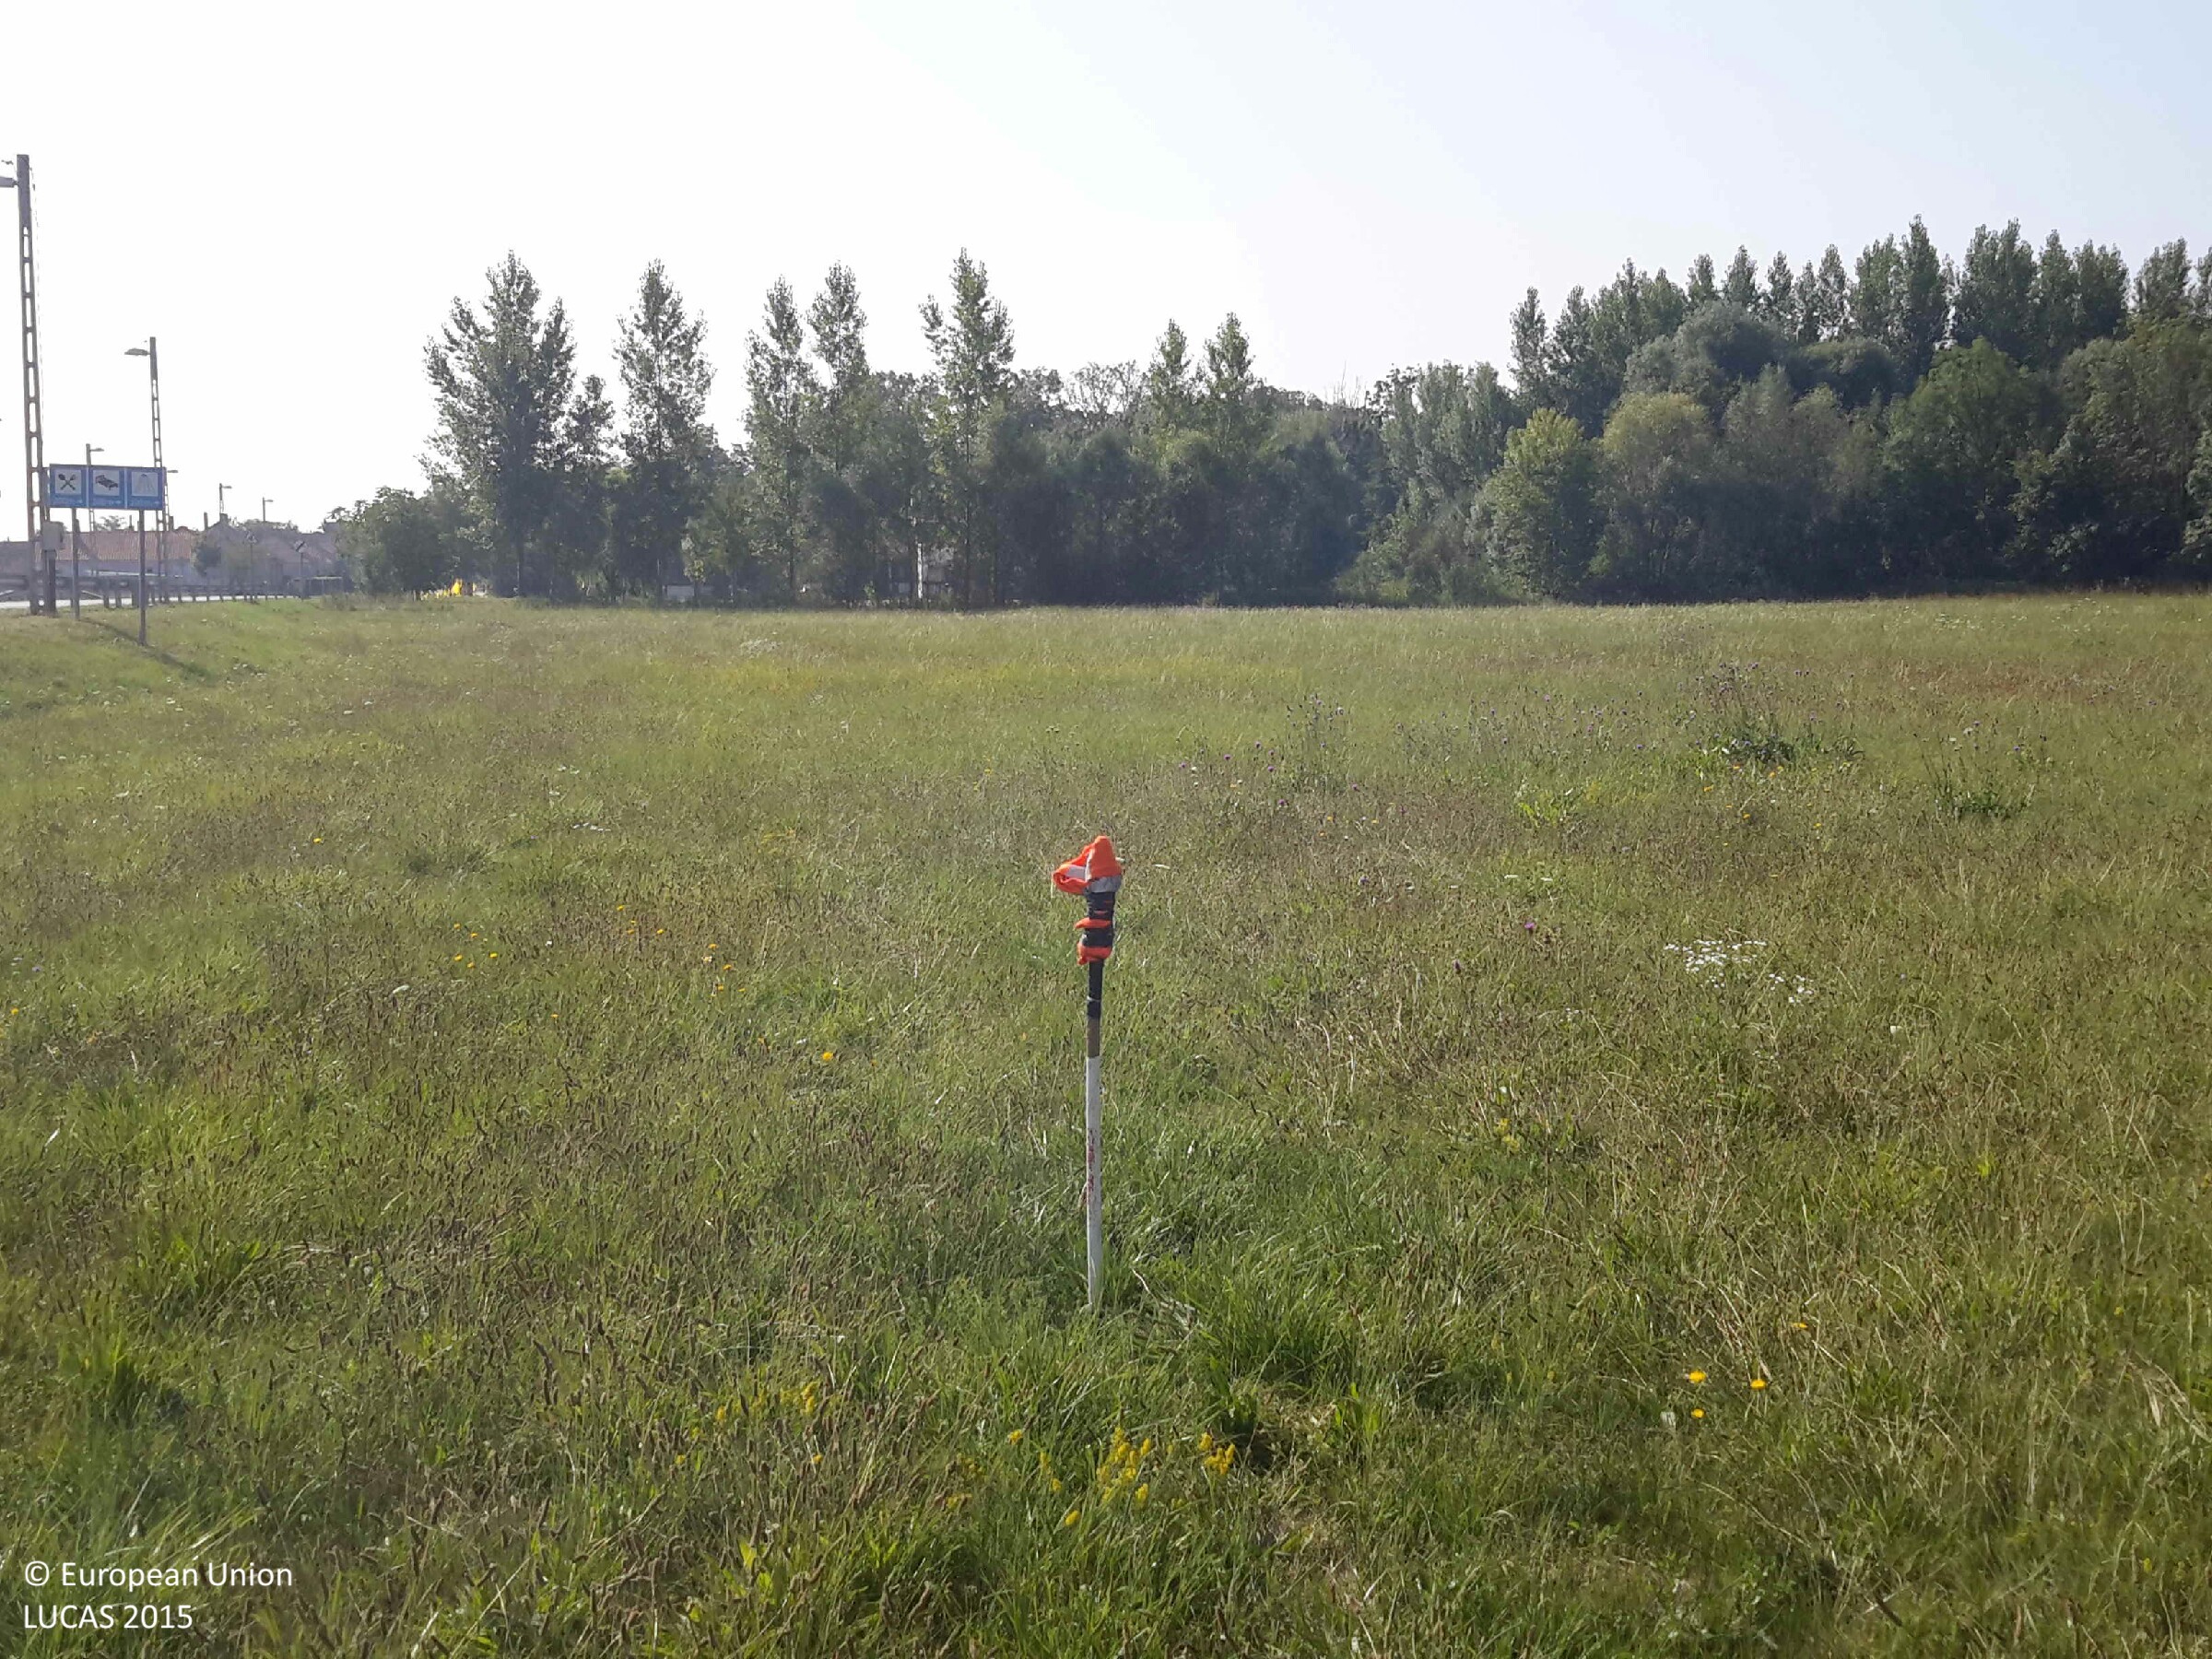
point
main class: Grassland
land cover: Grassland without tree/shrub cover
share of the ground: > 75 %
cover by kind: herbaceous plants 100 %
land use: Agriculture (excluding fallow land and kitchen gardens)
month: August
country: HU
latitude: 47.6961
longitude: 17.2427
